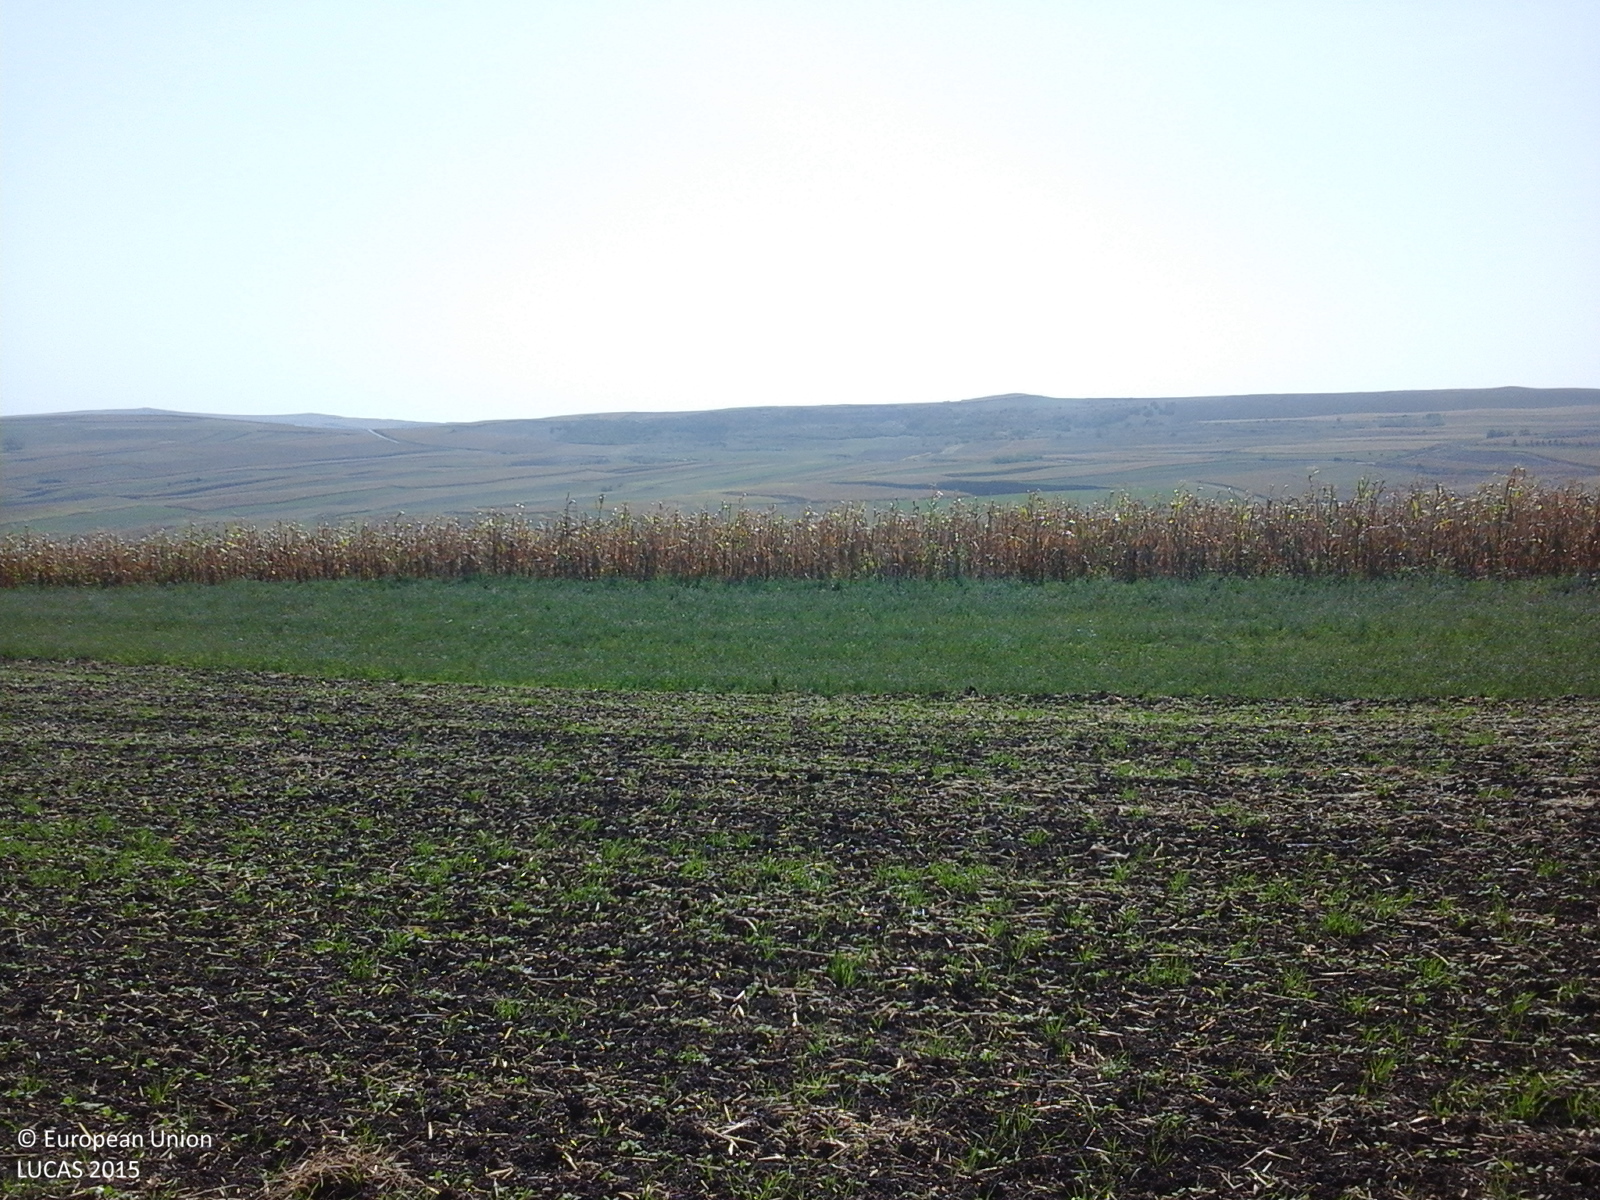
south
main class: Cropland
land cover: Rye
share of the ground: 25 - 50 %
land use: Agriculture (excluding fallow land and kitchen gardens)
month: September
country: RO
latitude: 46.6464
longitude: 24.0189
